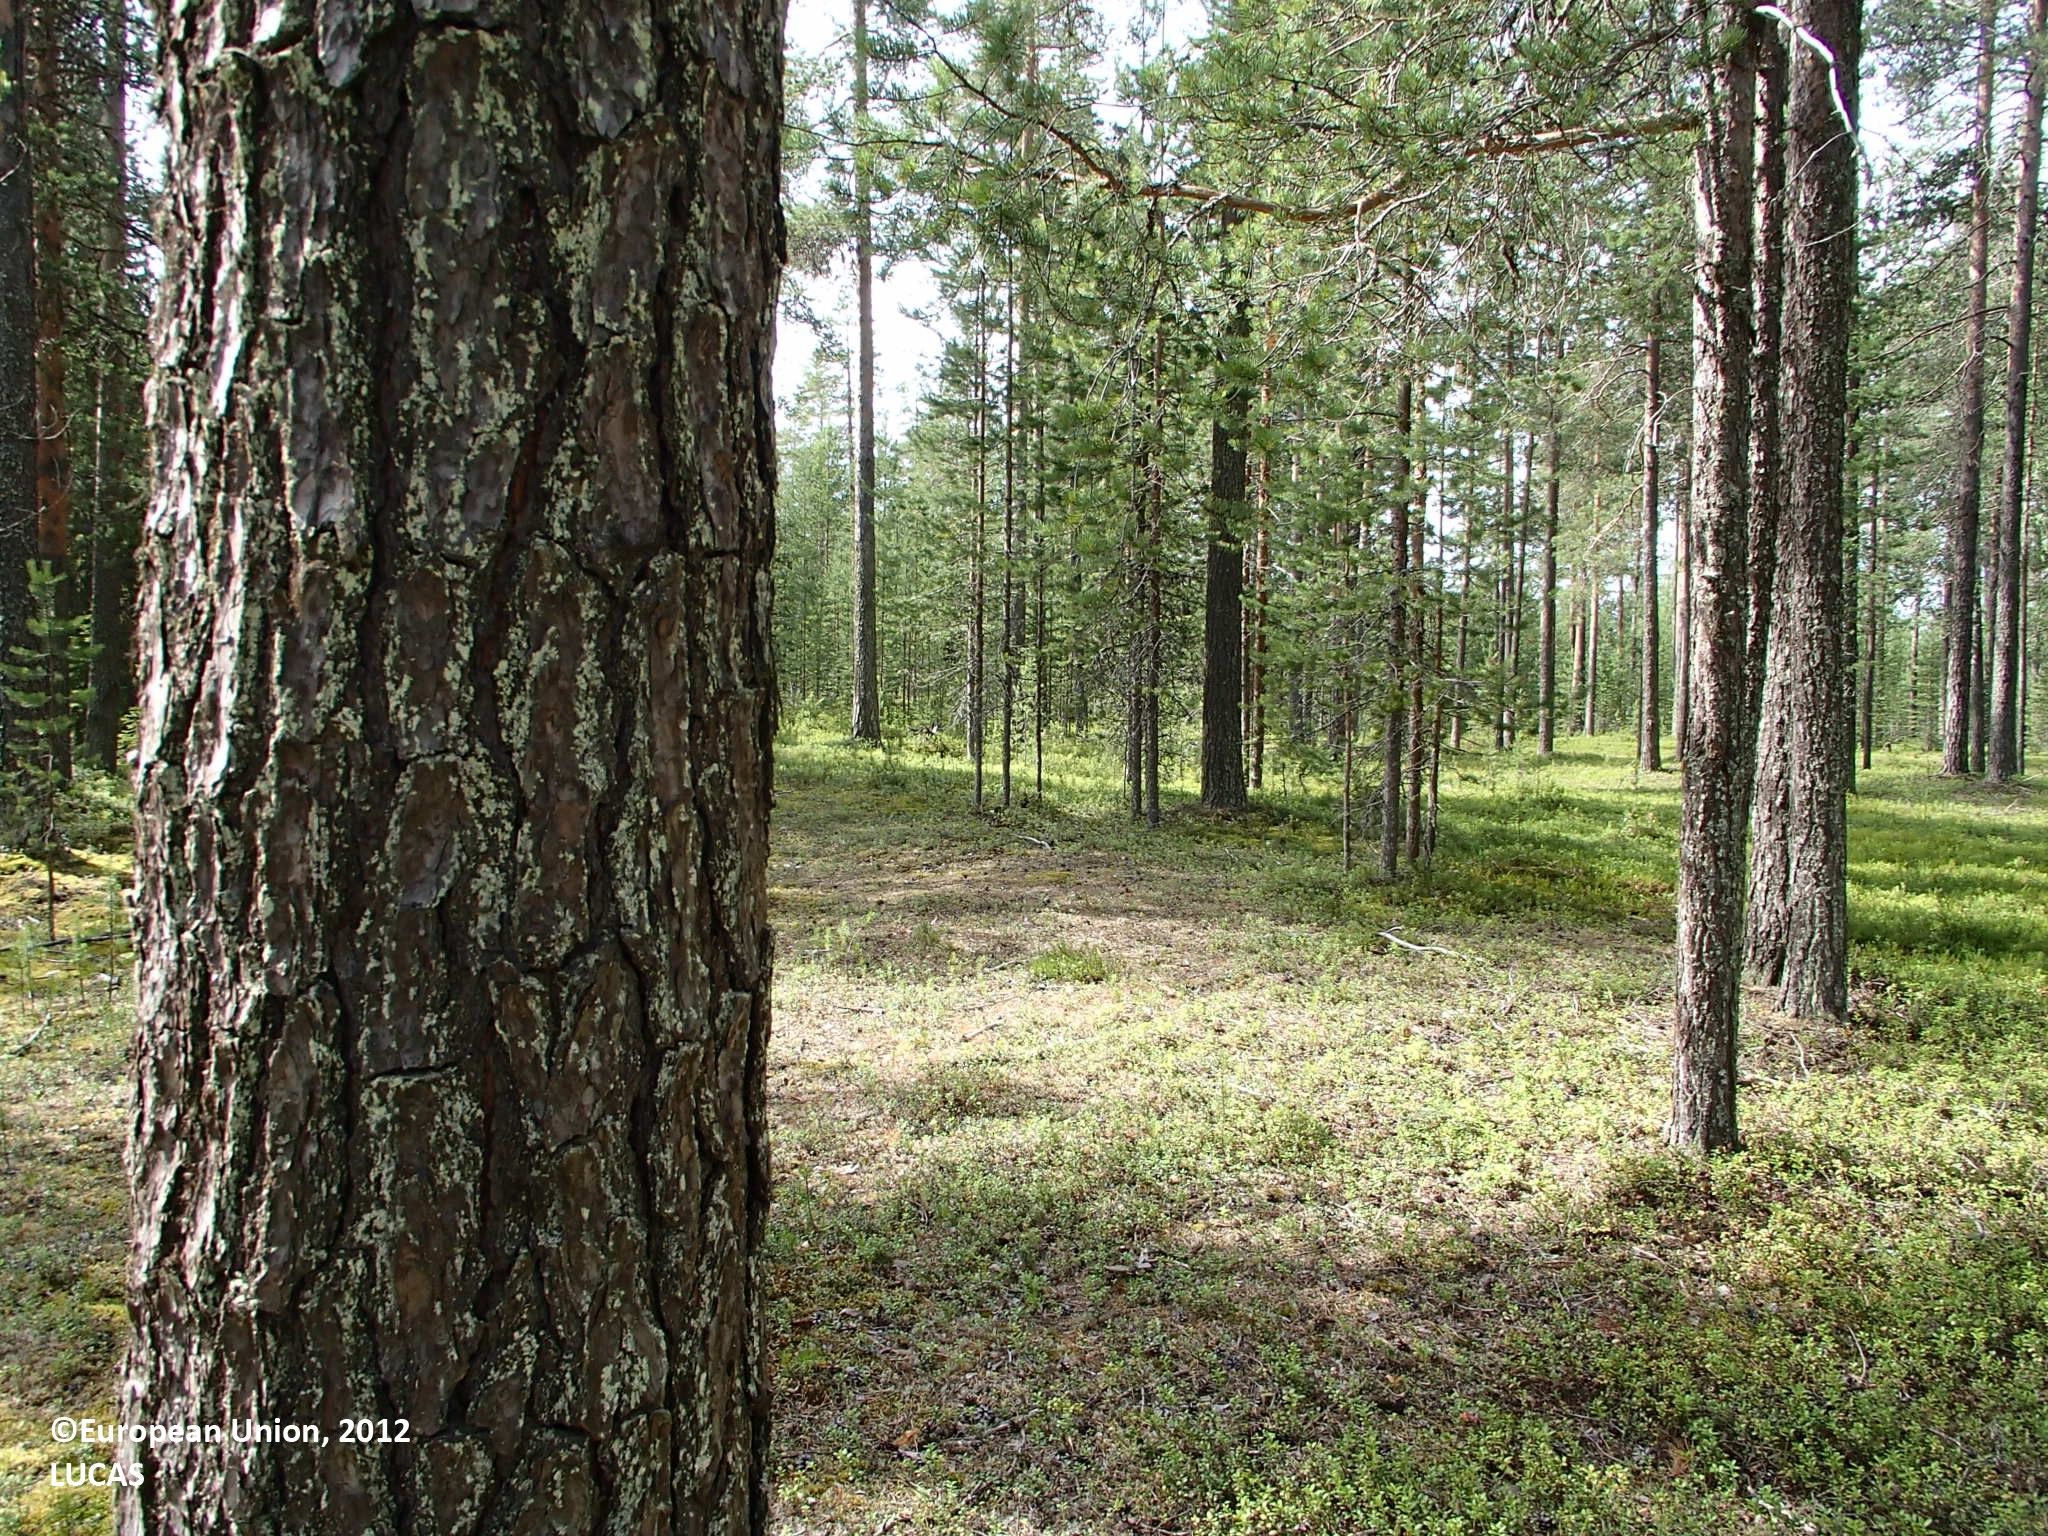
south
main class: Woodland
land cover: Pine dominated coniferous woodland
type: boreal forest
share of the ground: > 75 %
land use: Forestry
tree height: > 5 m
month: July
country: FI
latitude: 66.4071
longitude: 25.4922
